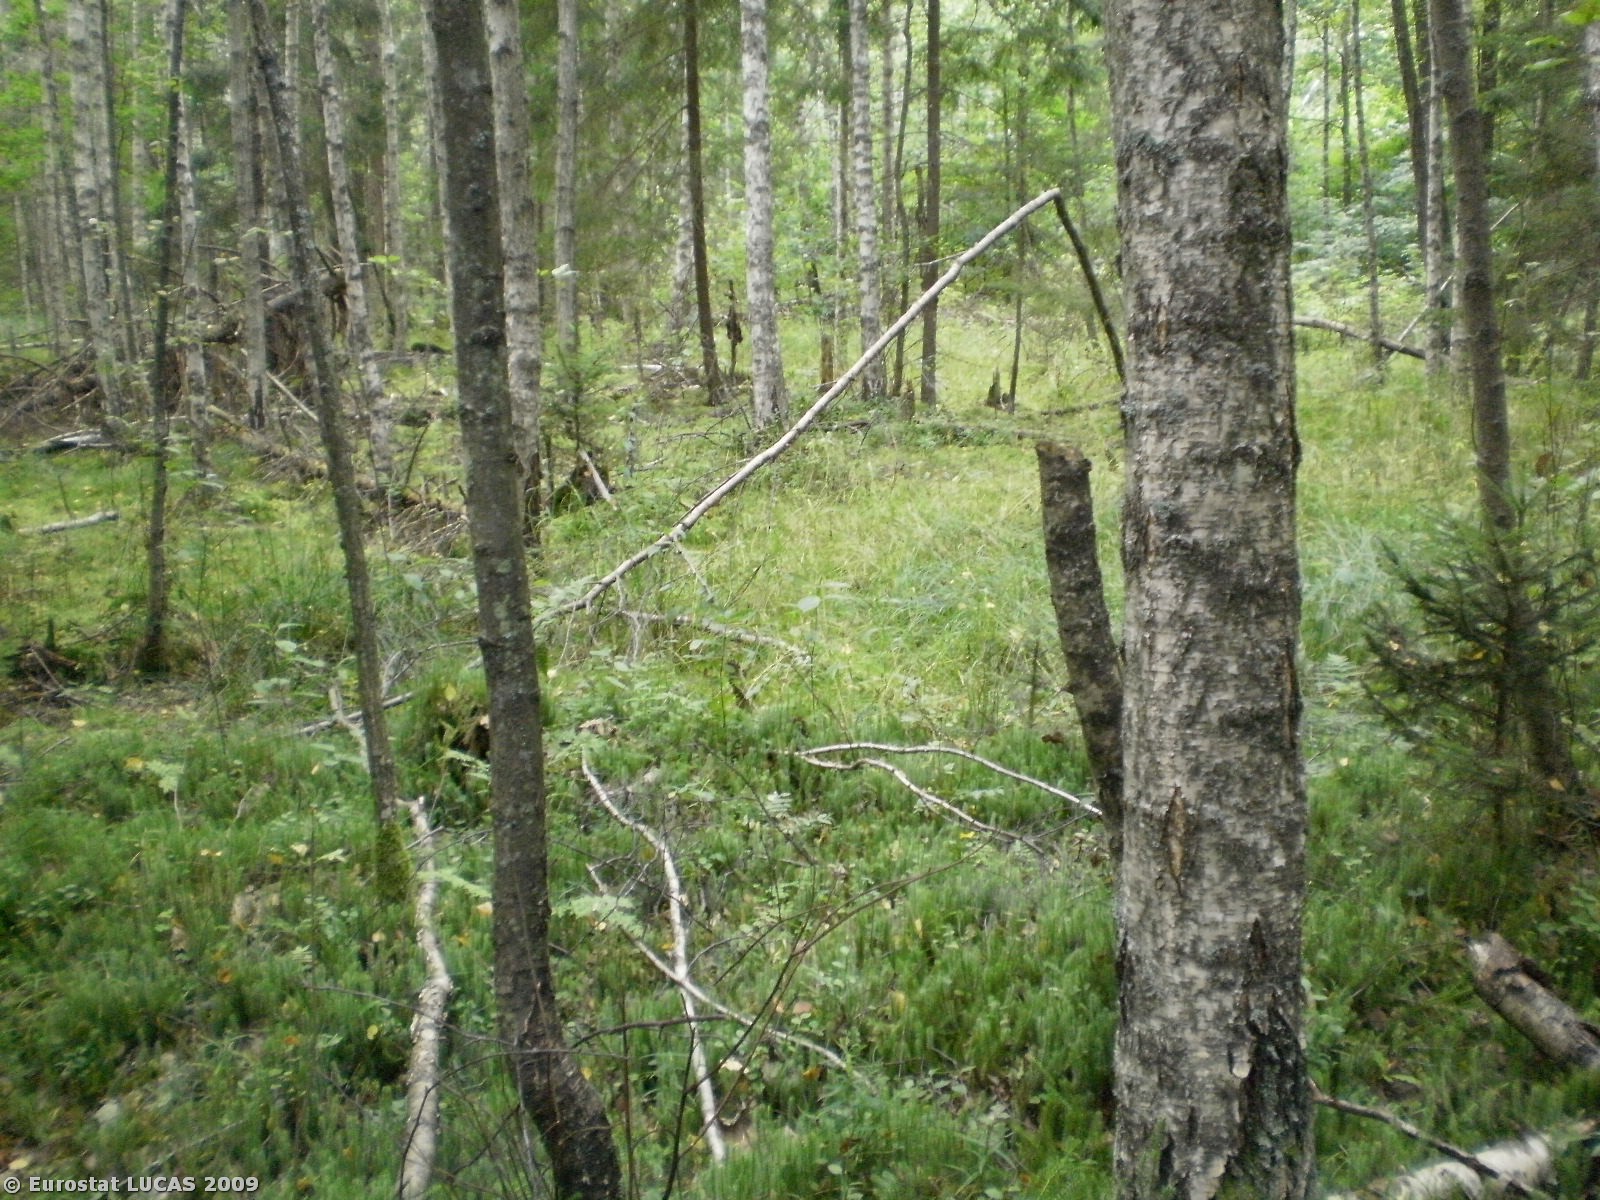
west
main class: Woodland
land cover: Mixed woodland
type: hemiboreal forest and nemoral coniferous forest and mixed broadleaved-coniferous forest
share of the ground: > 75 %
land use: Forestry
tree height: > 5 m
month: August
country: PL
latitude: 54.1322
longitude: 22.1647
